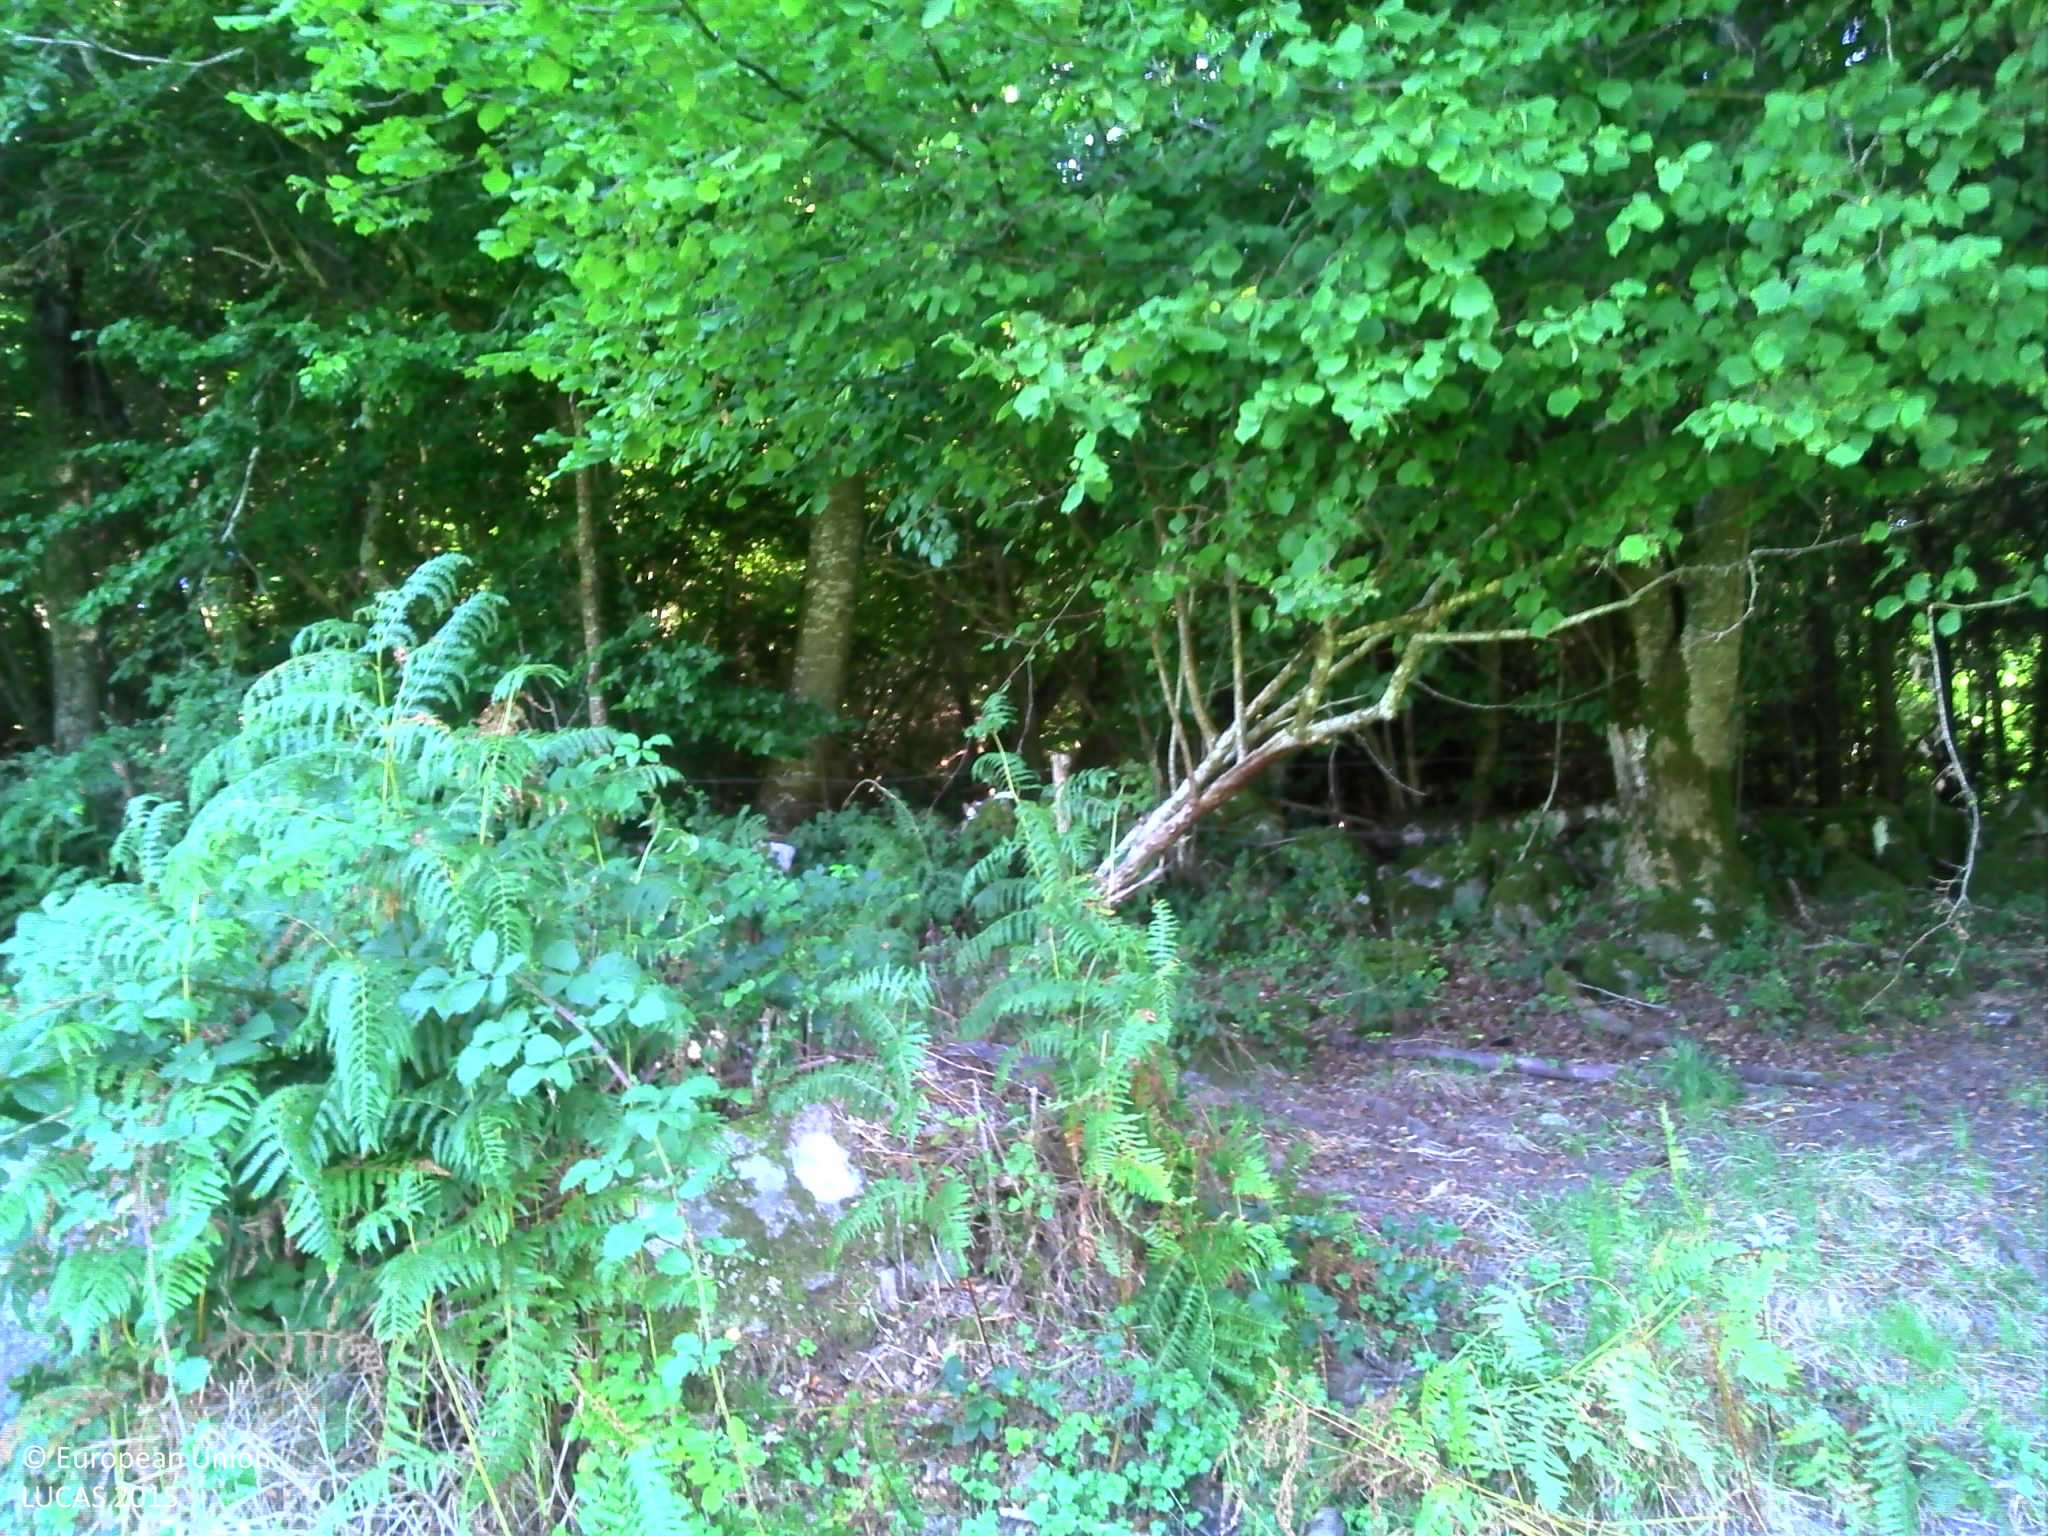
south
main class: Grassland
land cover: Grassland without tree/shrub cover
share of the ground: > 75 %
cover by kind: herbaceous plants 100 %
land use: Agriculture (excluding fallow land and kitchen gardens)
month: August
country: FR
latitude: 45.8352
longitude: 2.2588
